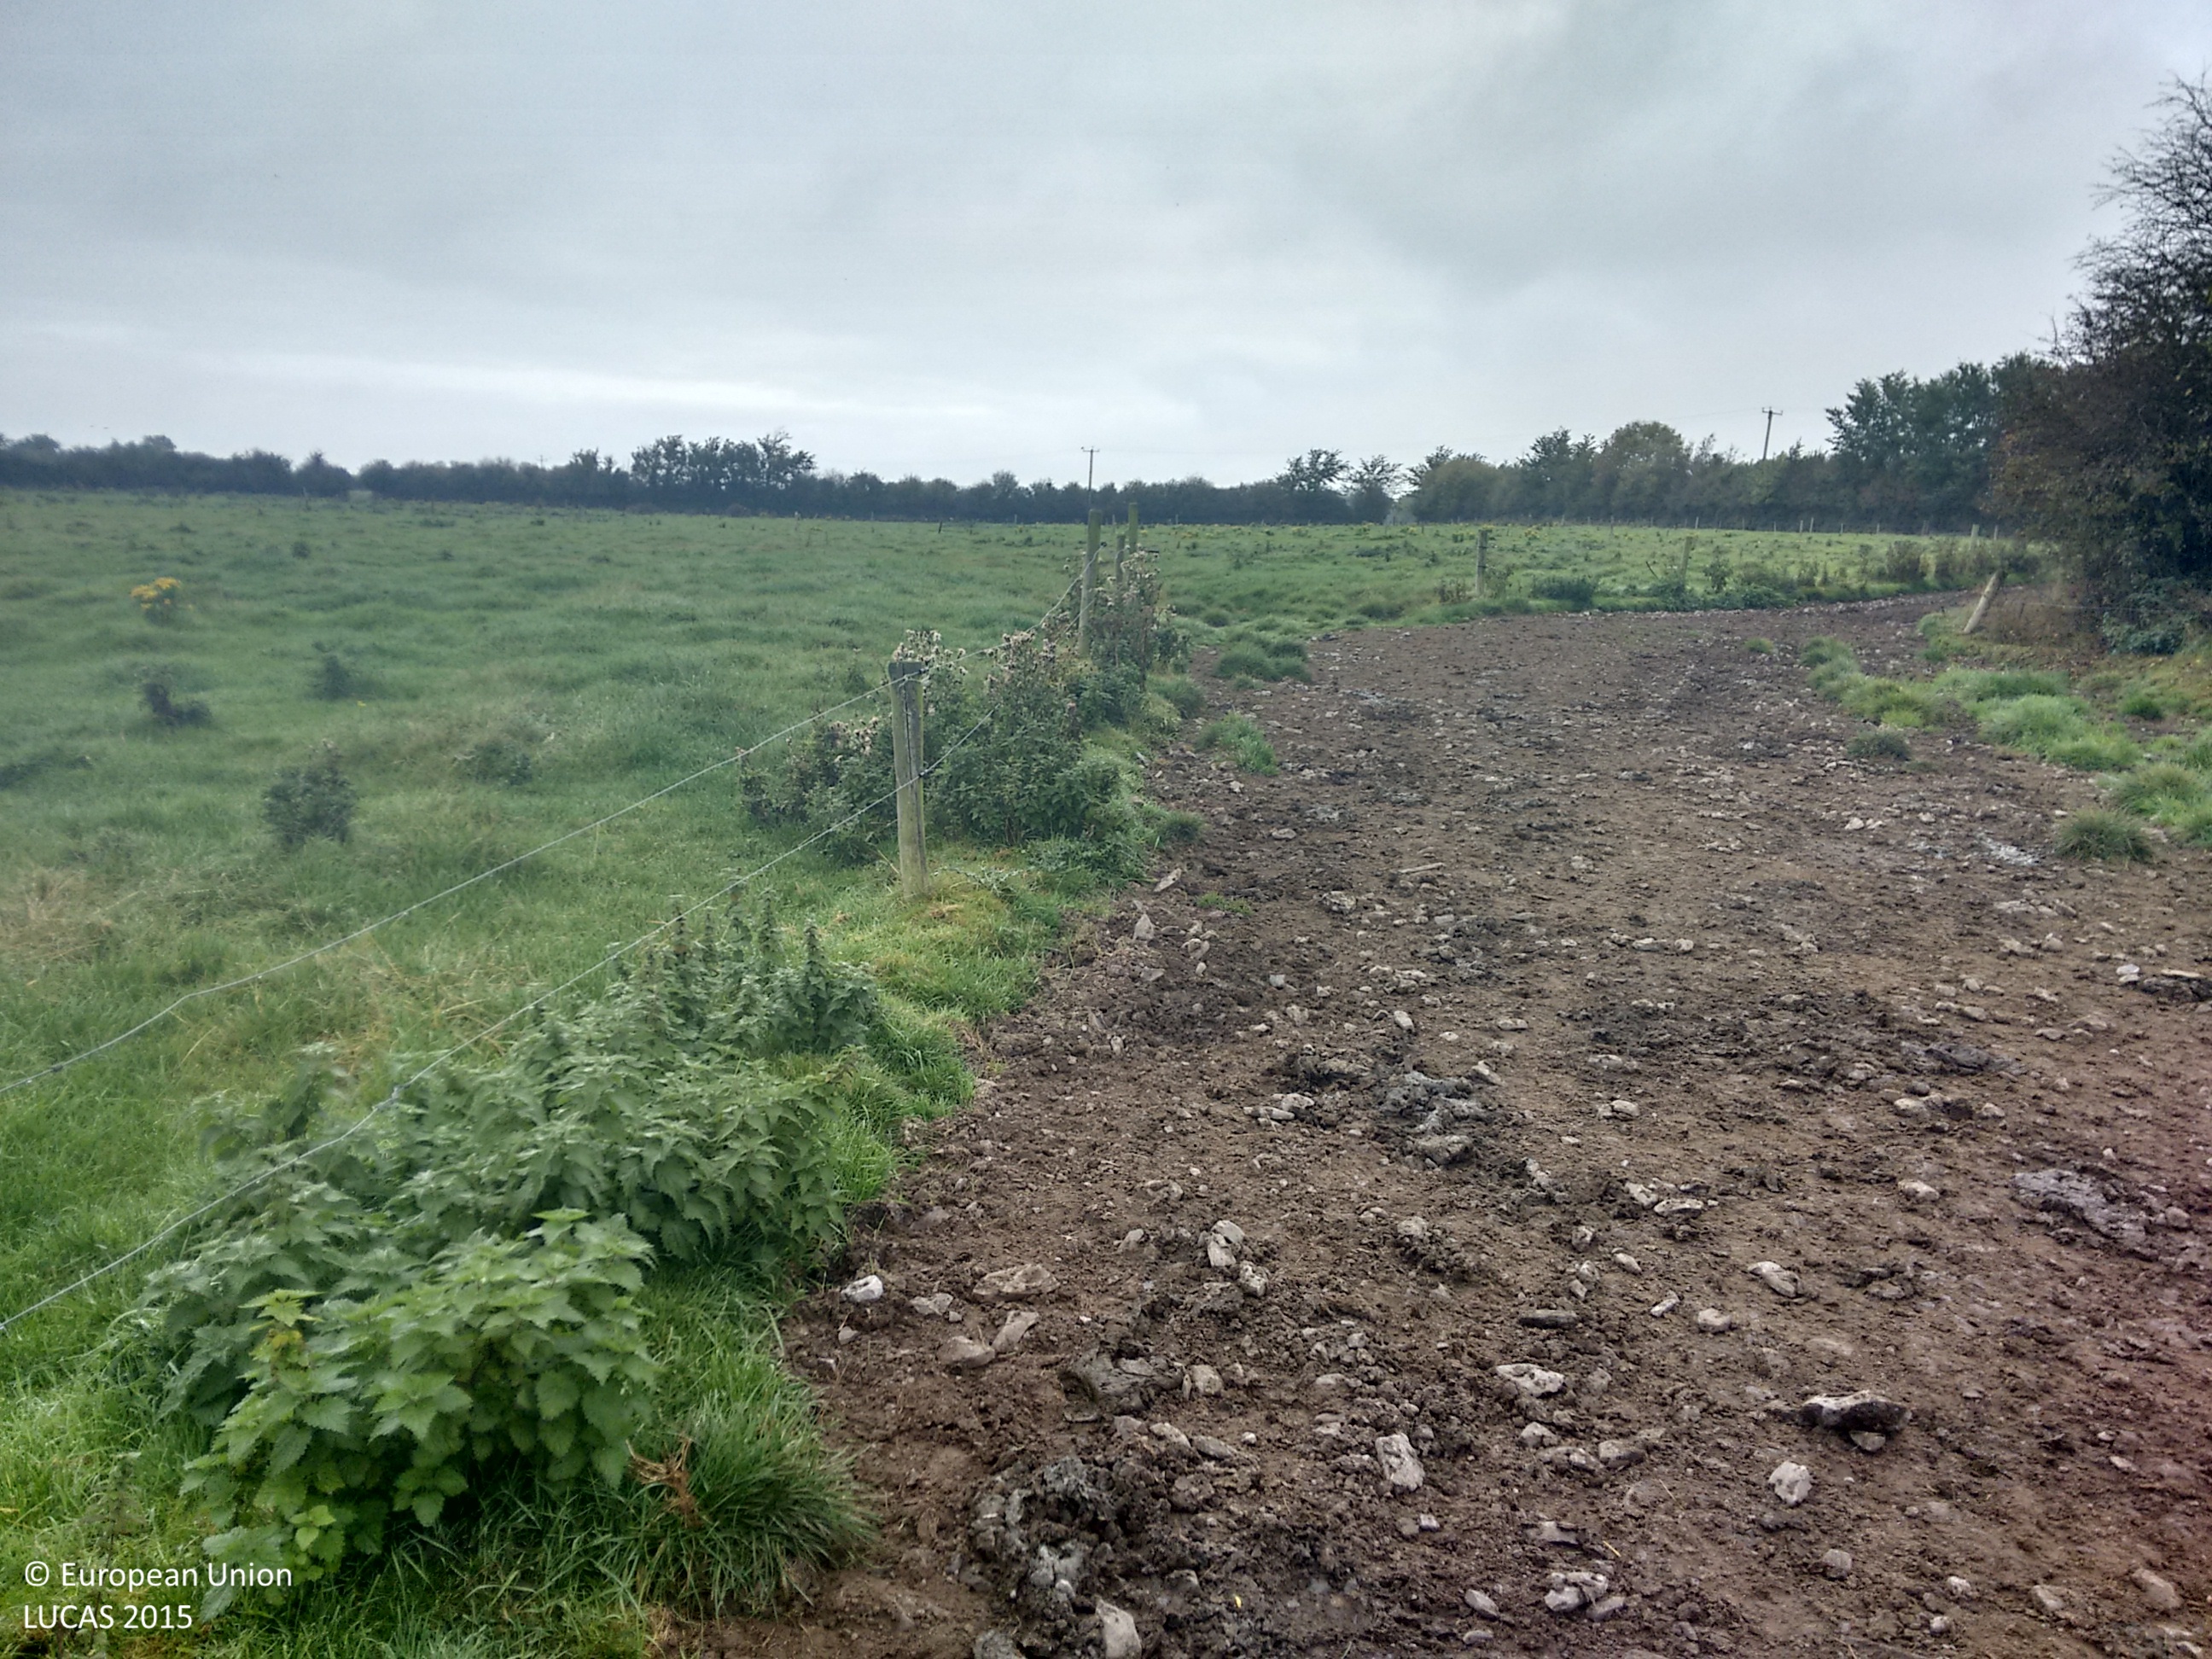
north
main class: Grassland
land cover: Grassland without tree/shrub cover
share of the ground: > 75 %
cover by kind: herbaceous plants 100 %
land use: Agriculture (excluding fallow land and kitchen gardens)
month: October
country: IE
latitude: 52.6477
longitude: -7.7409
